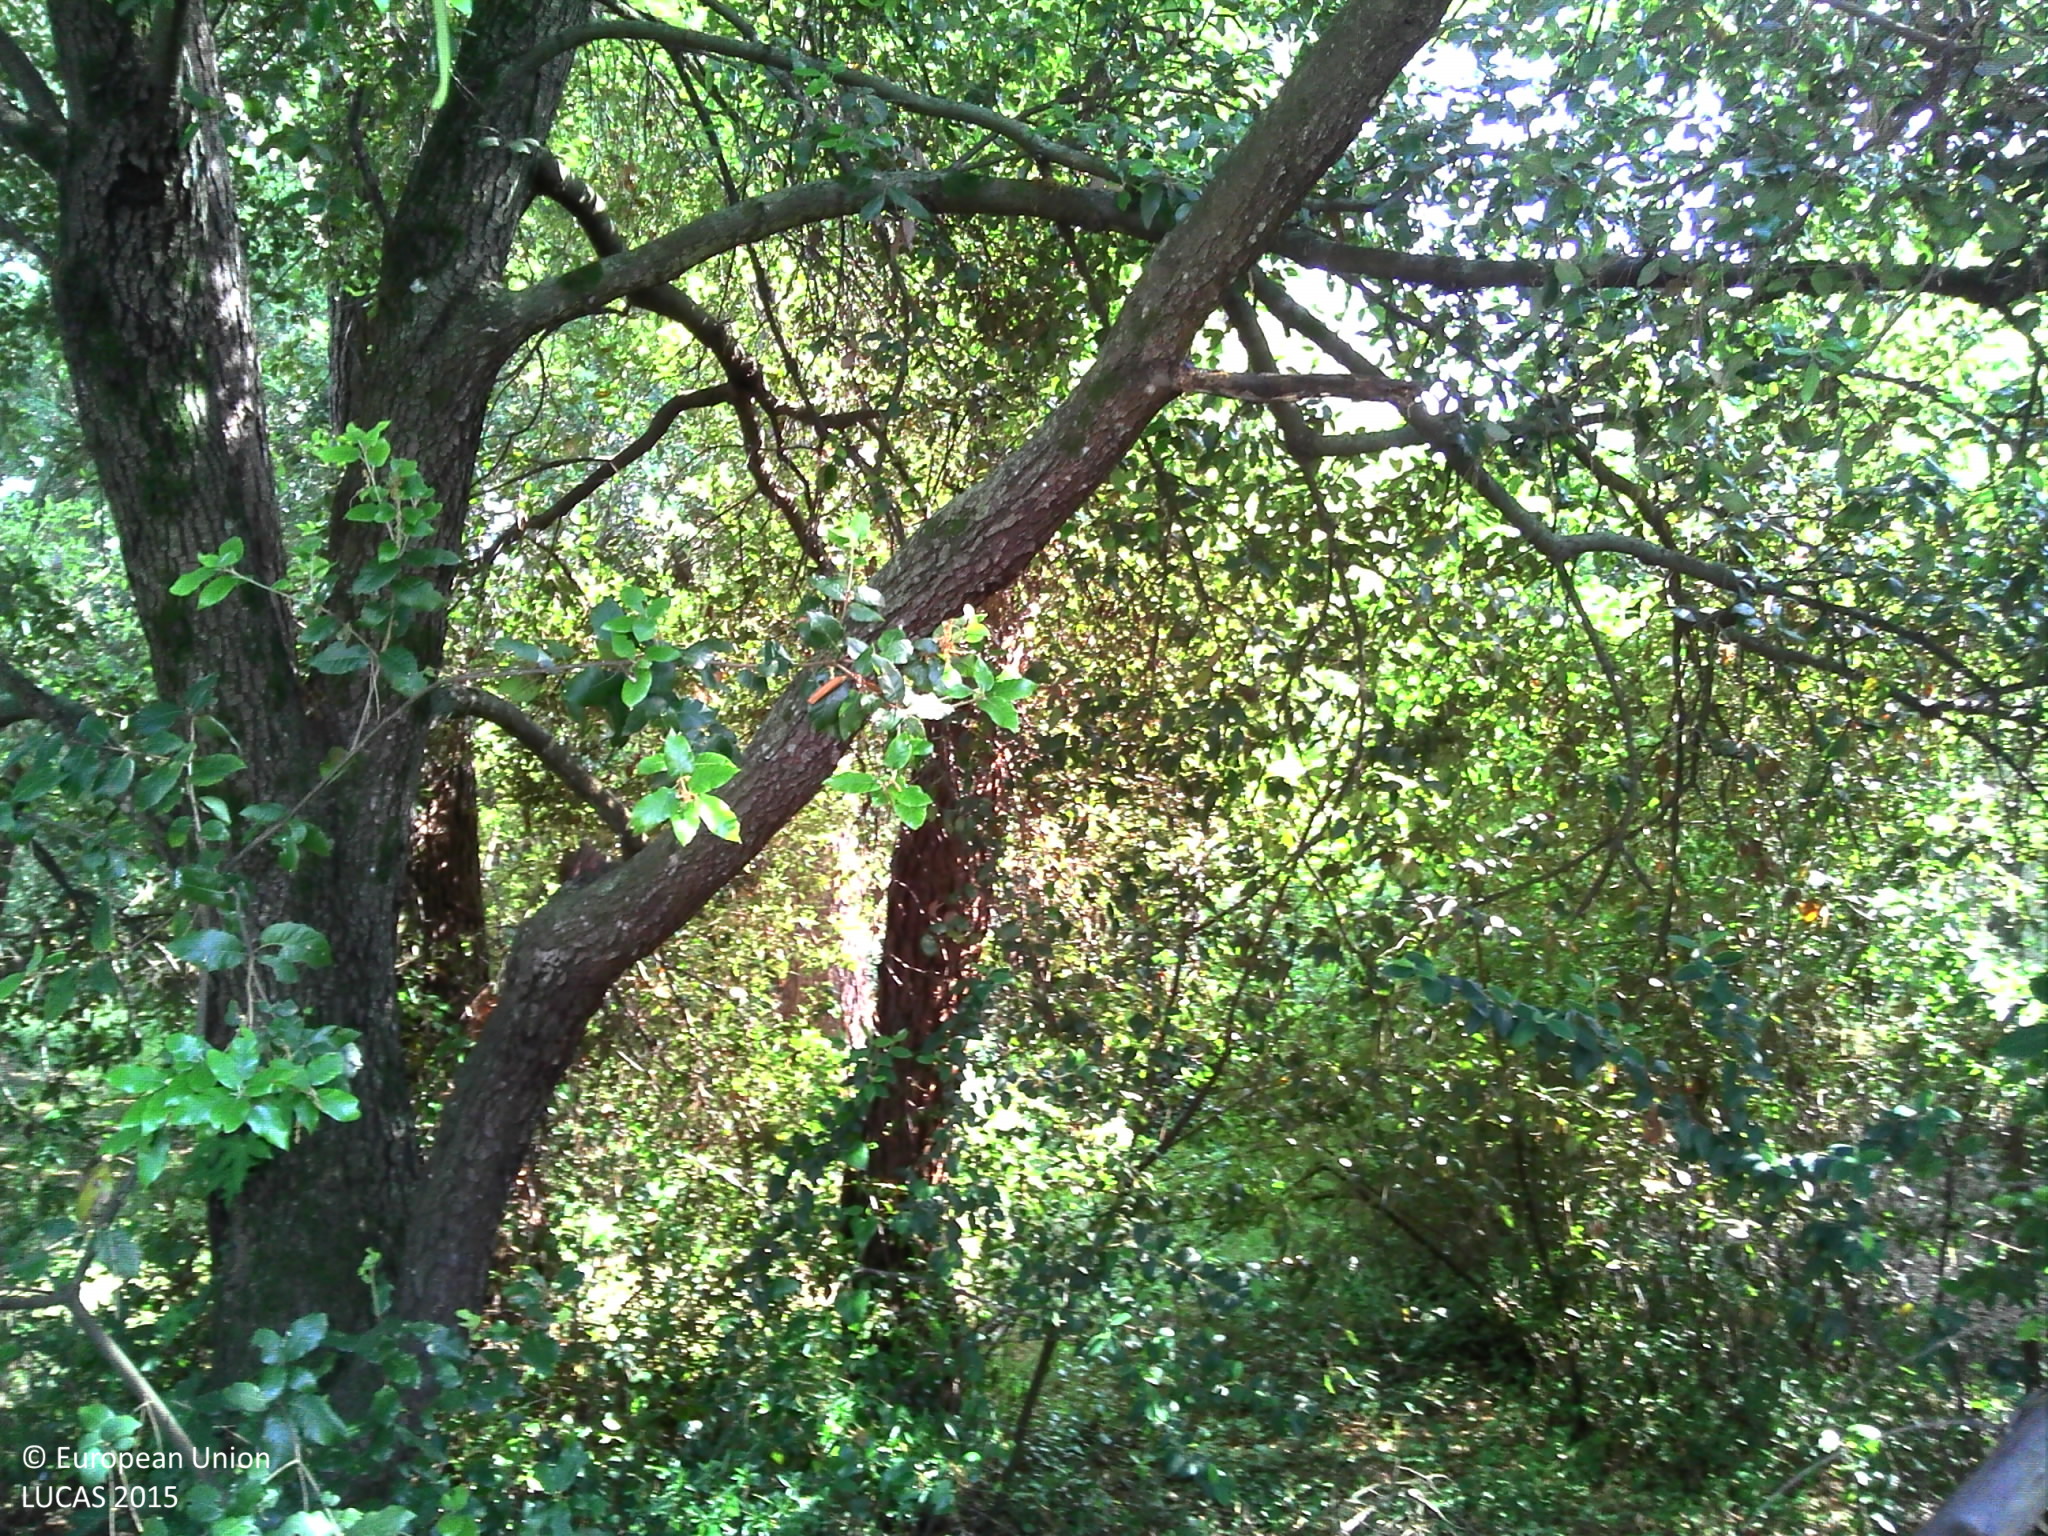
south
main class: Woodland
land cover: Pine dominated mixed woodland
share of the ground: > 75 %
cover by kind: coniferous forest trees 40 %, broadleaved forest trees 40 %, herbaceous plants 20 %
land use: Residential
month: June
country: FR
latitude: 43.6586
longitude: 7.0436
